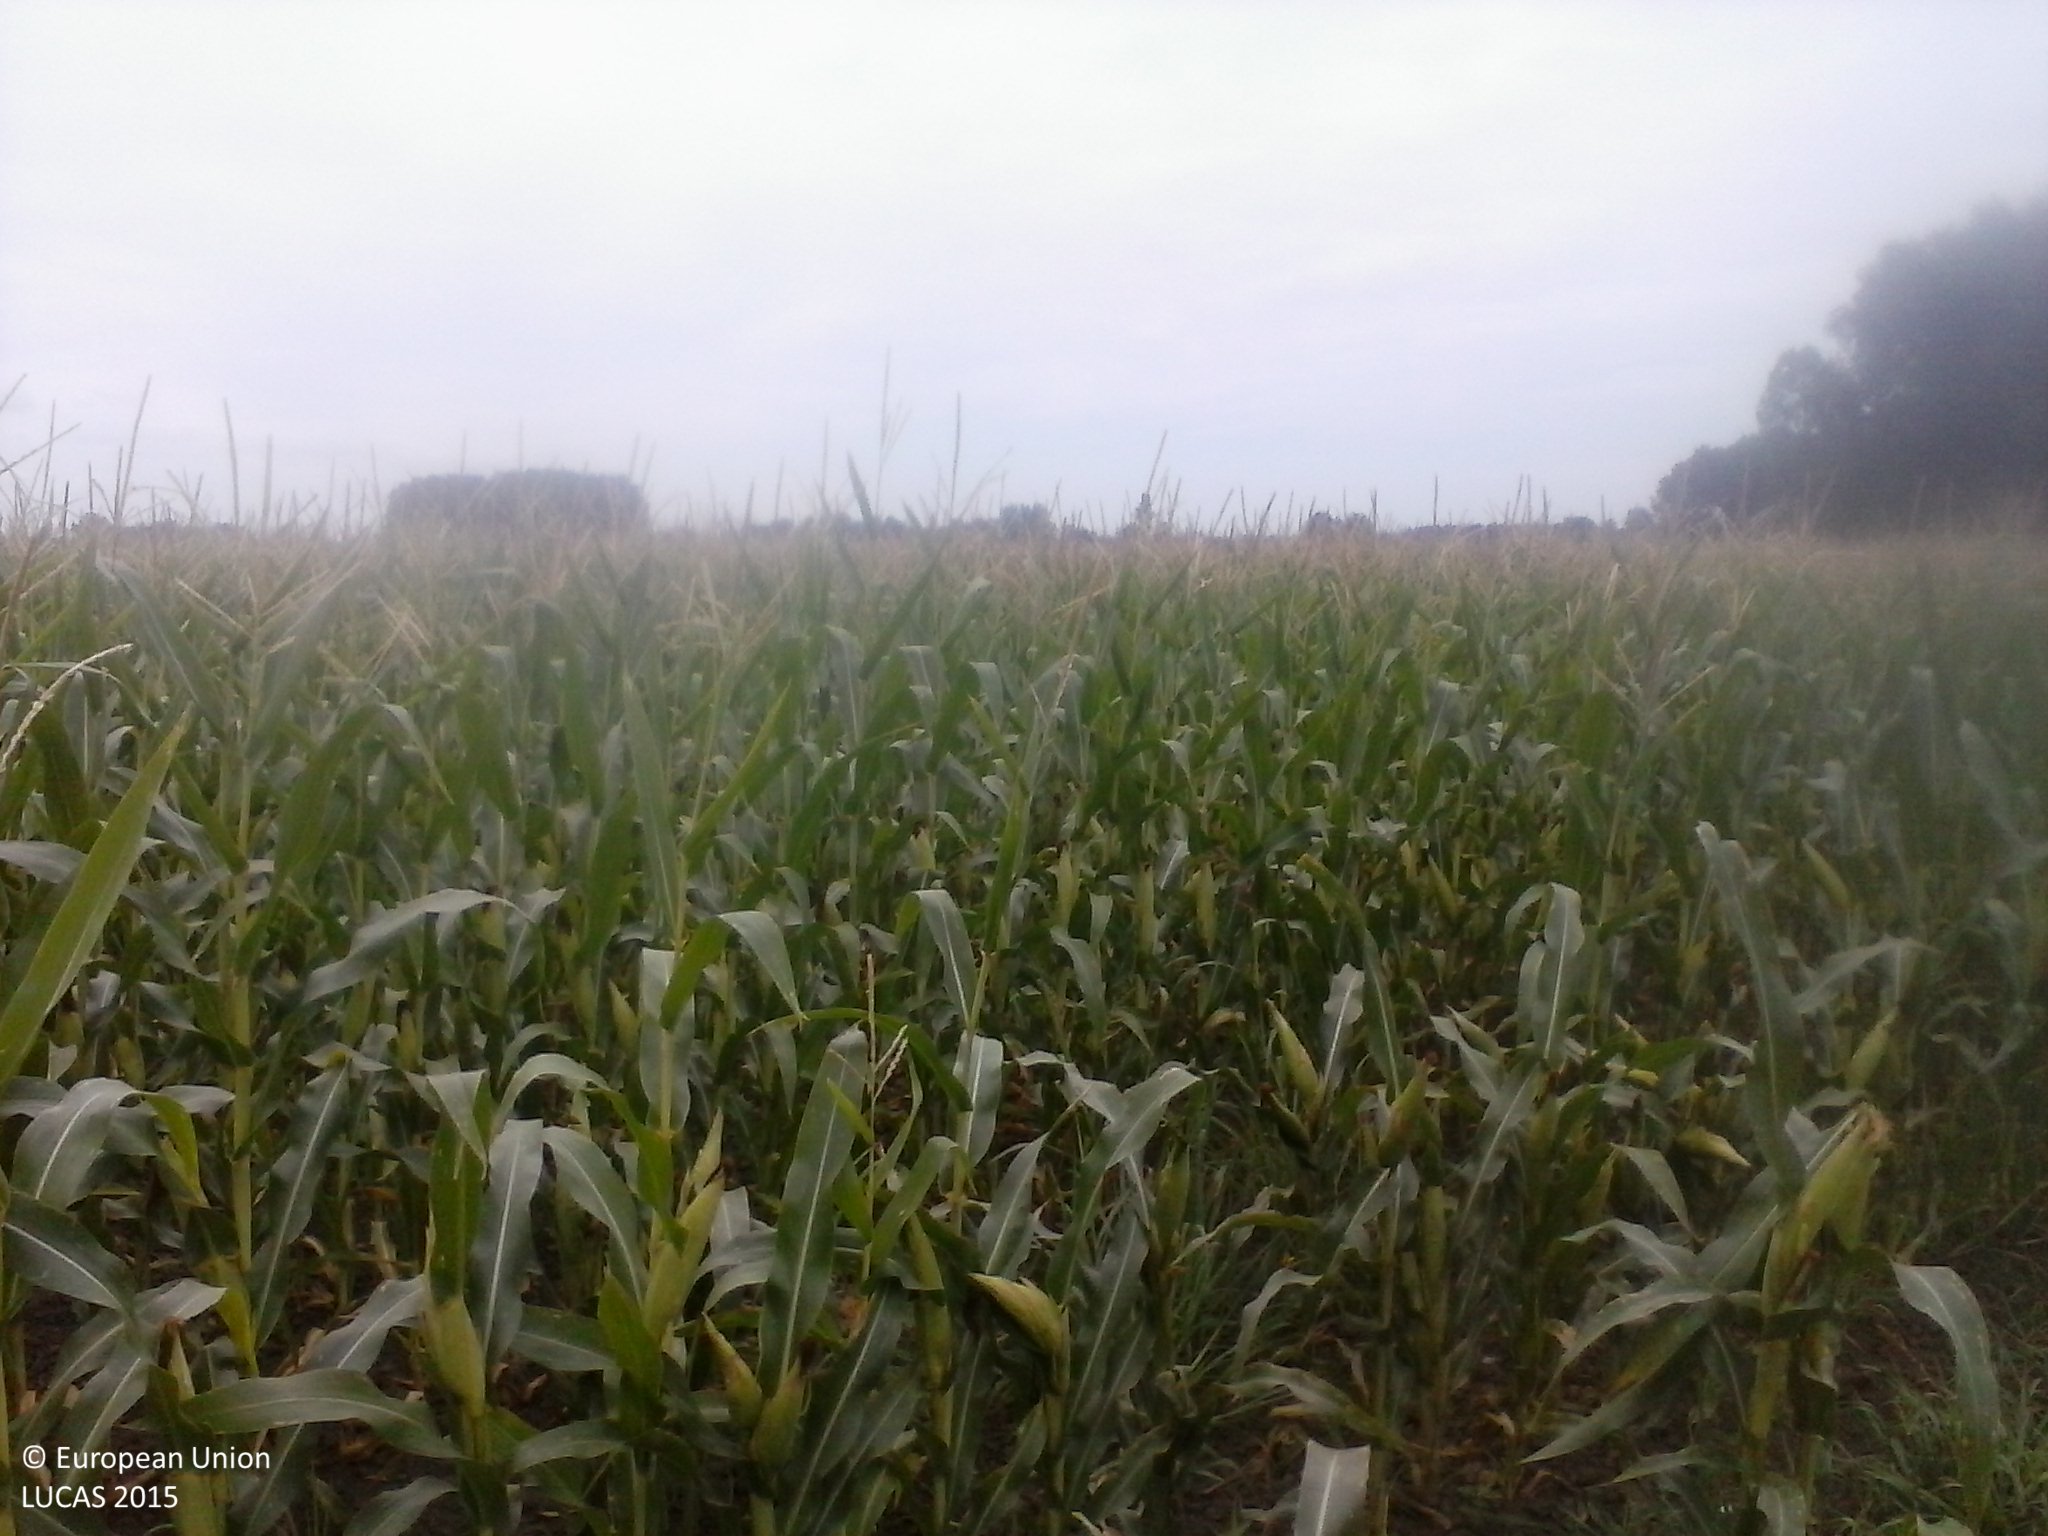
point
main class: Cropland
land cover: Maize
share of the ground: > 75 %
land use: Agriculture (excluding fallow land and kitchen gardens)
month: July
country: HU
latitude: 45.9803
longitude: 17.7361
